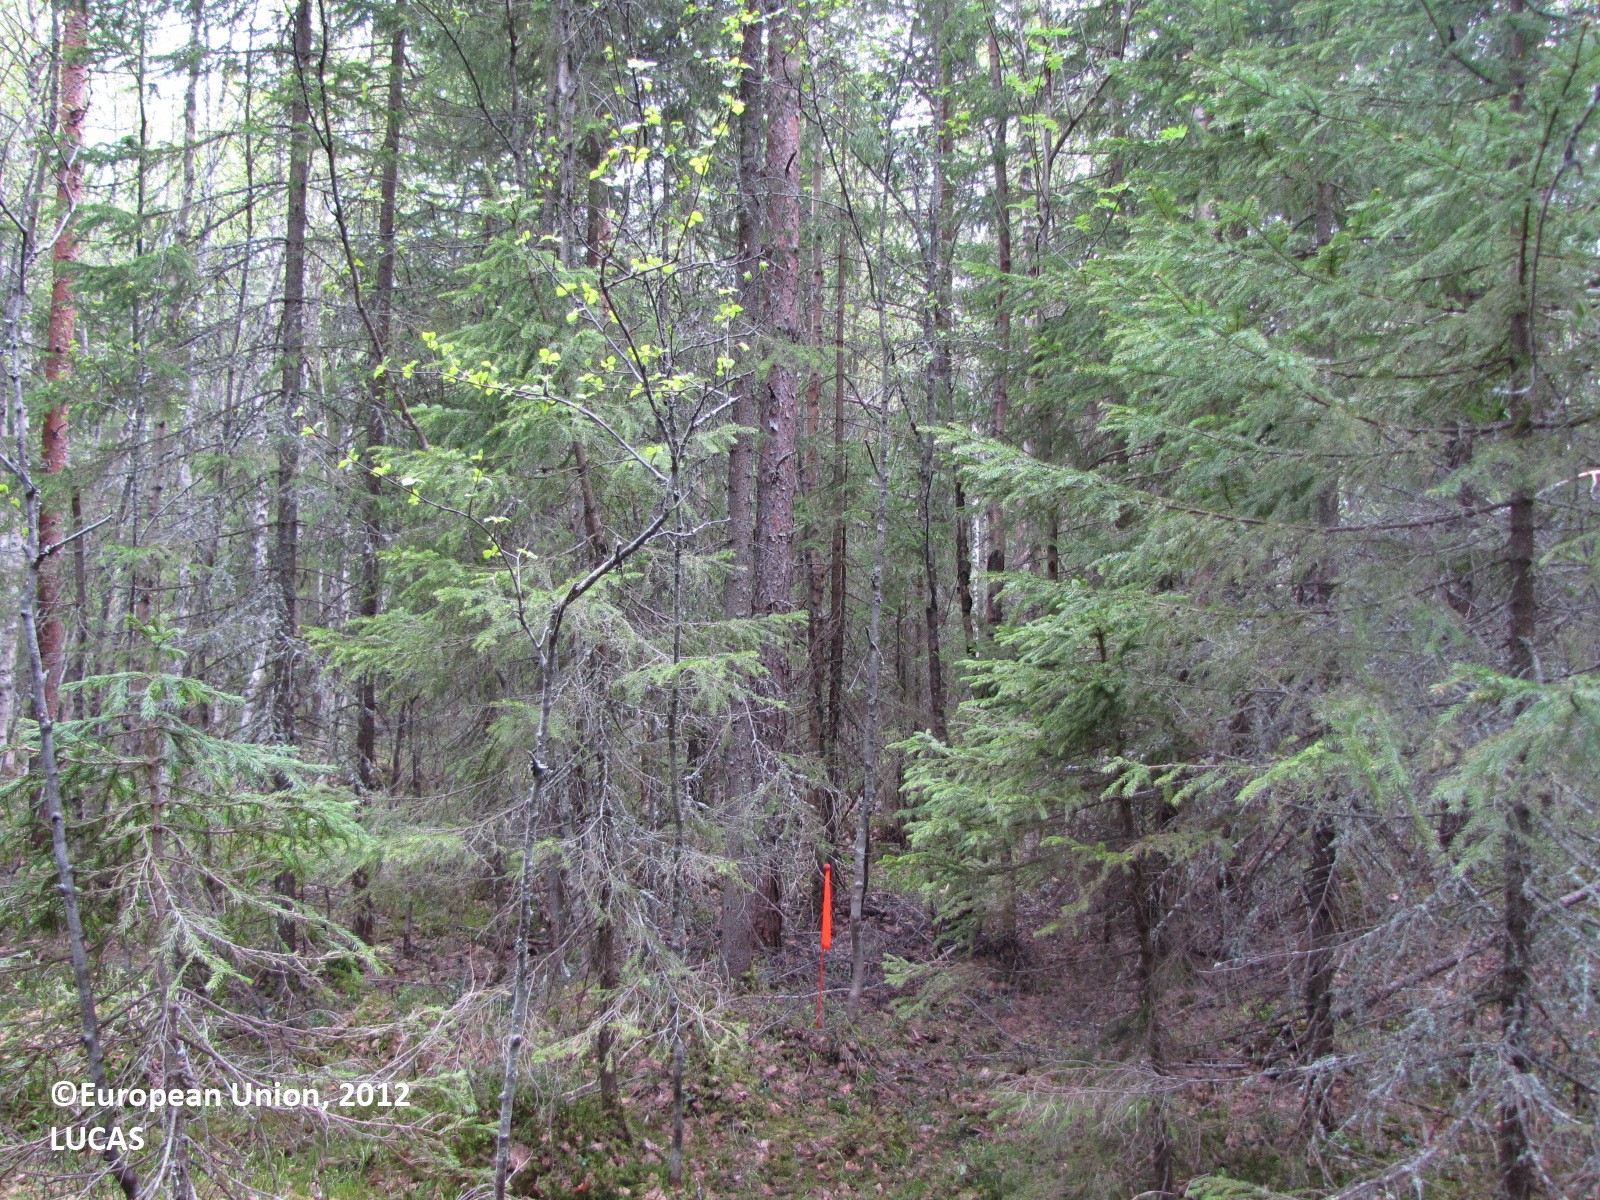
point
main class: Woodland
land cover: Spruce dominated mixed woodland
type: boreal forest
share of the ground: > 75 %
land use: Forestry
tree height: > 5 m
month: June
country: FI
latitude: 65.8110
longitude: 24.5109
